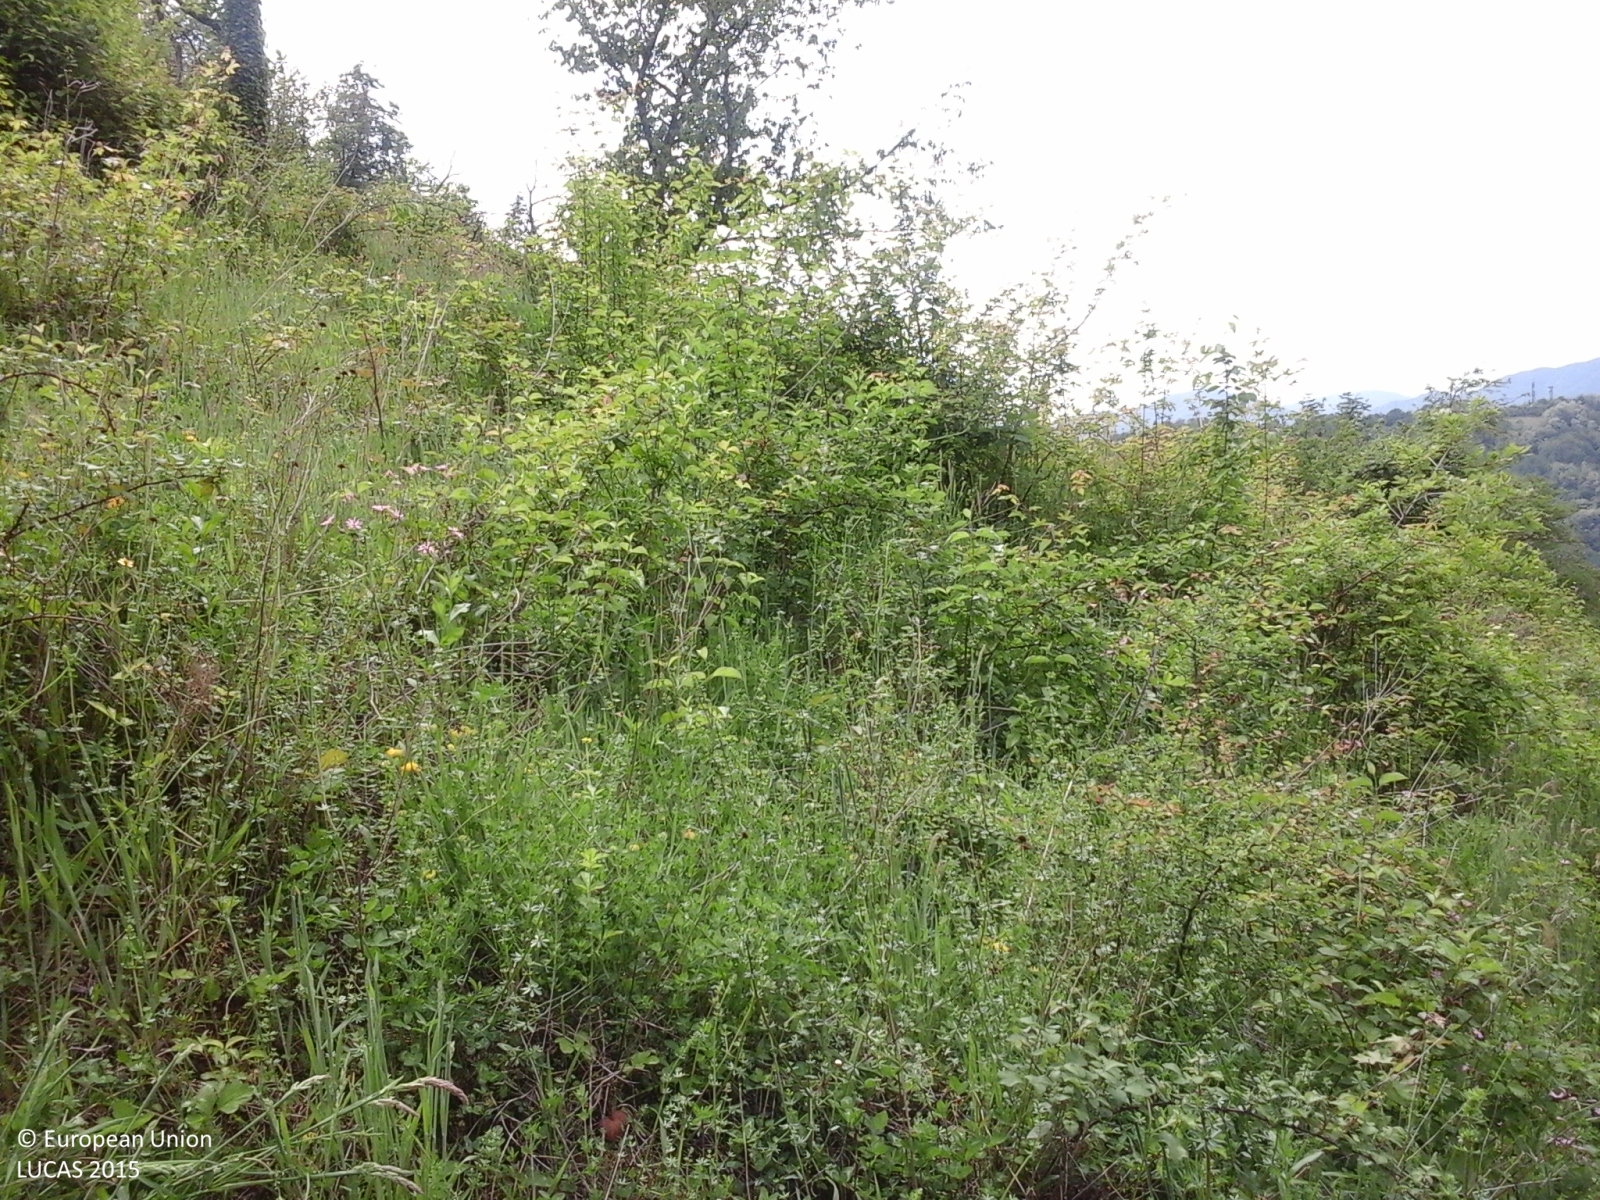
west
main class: Grassland
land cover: Grassland with sparse tree/shrub cover
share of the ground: > 75 %
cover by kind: herbaceous plants 85 %, shrubs 10 %, broadleaved forest trees 5 %
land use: Semi-natural and natural areas not in use
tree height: < 5 m
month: May
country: IT
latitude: 44.0191
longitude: 11.1822
